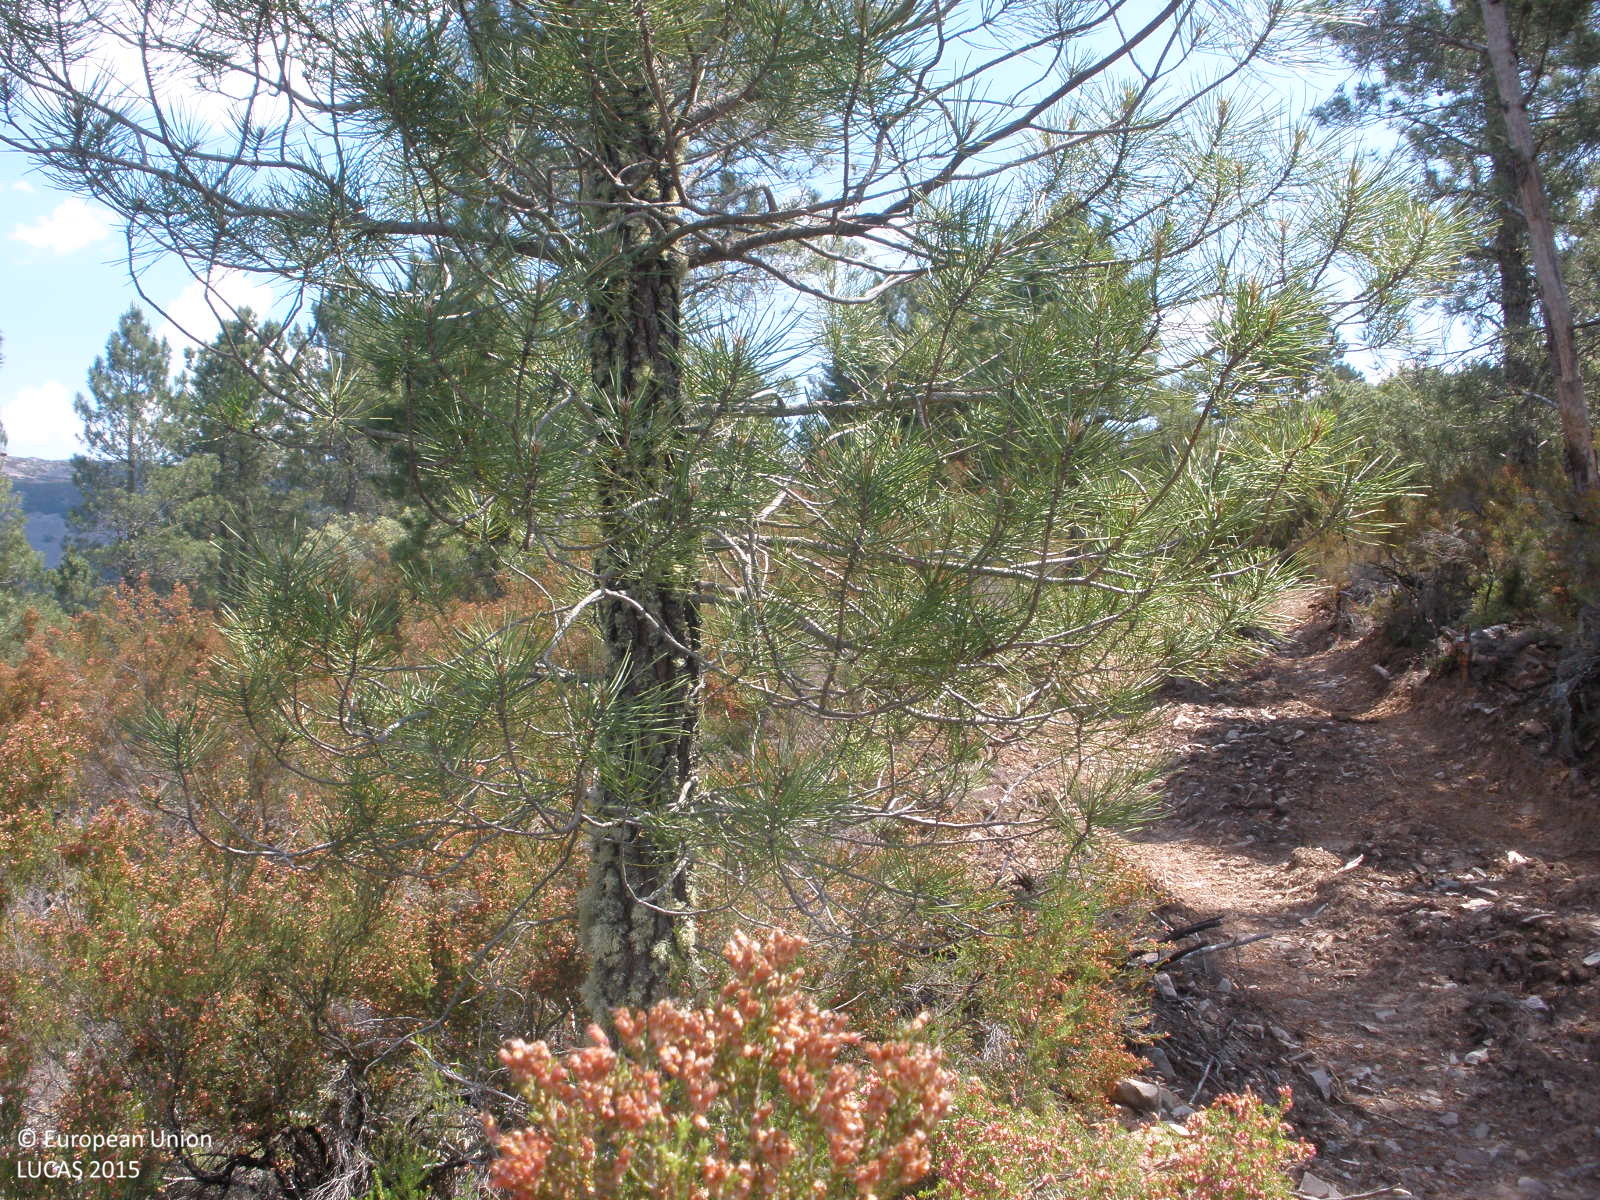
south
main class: Woodland
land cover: Pine dominated coniferous woodland
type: coniferous forest of the mediterranean region
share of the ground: > 75 %
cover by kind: shrubs 80 %, coniferous forest trees 20 %
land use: Forestry
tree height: > 5 m
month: June
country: ES
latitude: 40.5373
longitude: -6.2696
